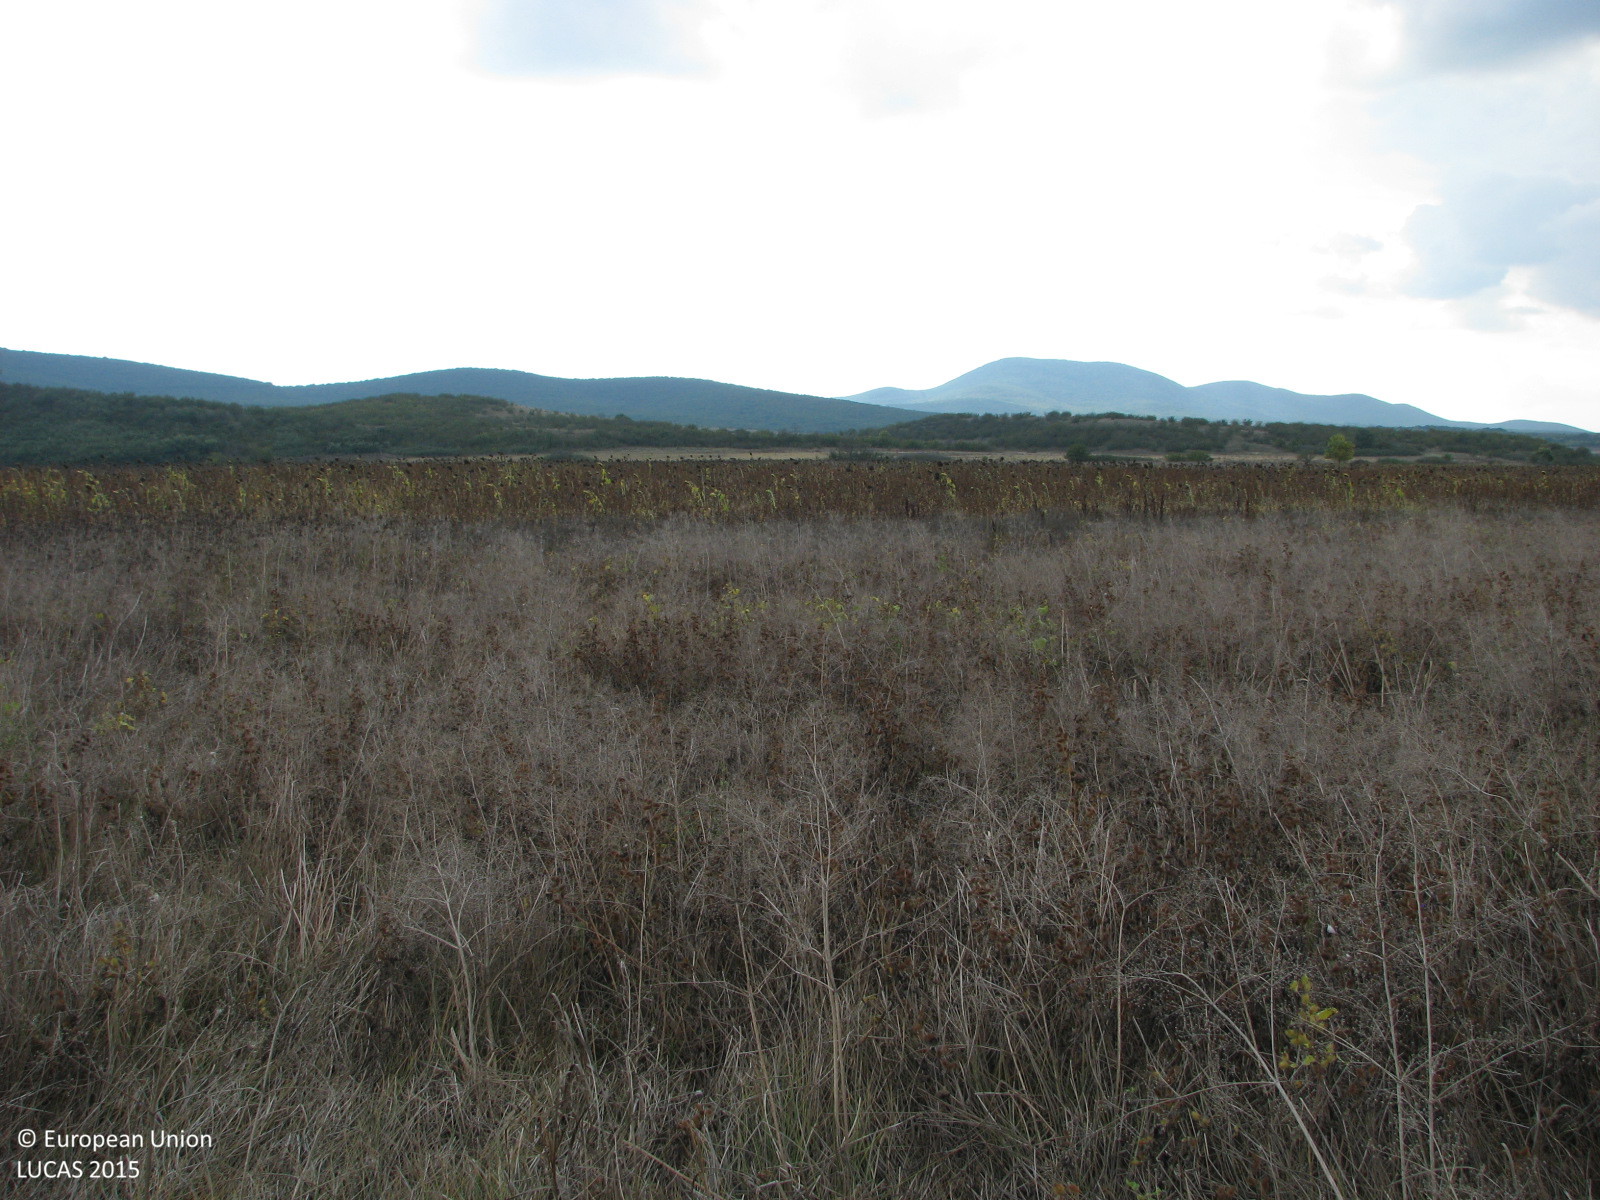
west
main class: Grassland
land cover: Spontaneously vegetated surfaces
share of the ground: > 75 %
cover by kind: herbaceous plants 100 %
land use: Fallow land
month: October
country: BG
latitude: 42.2602
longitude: 26.4160
